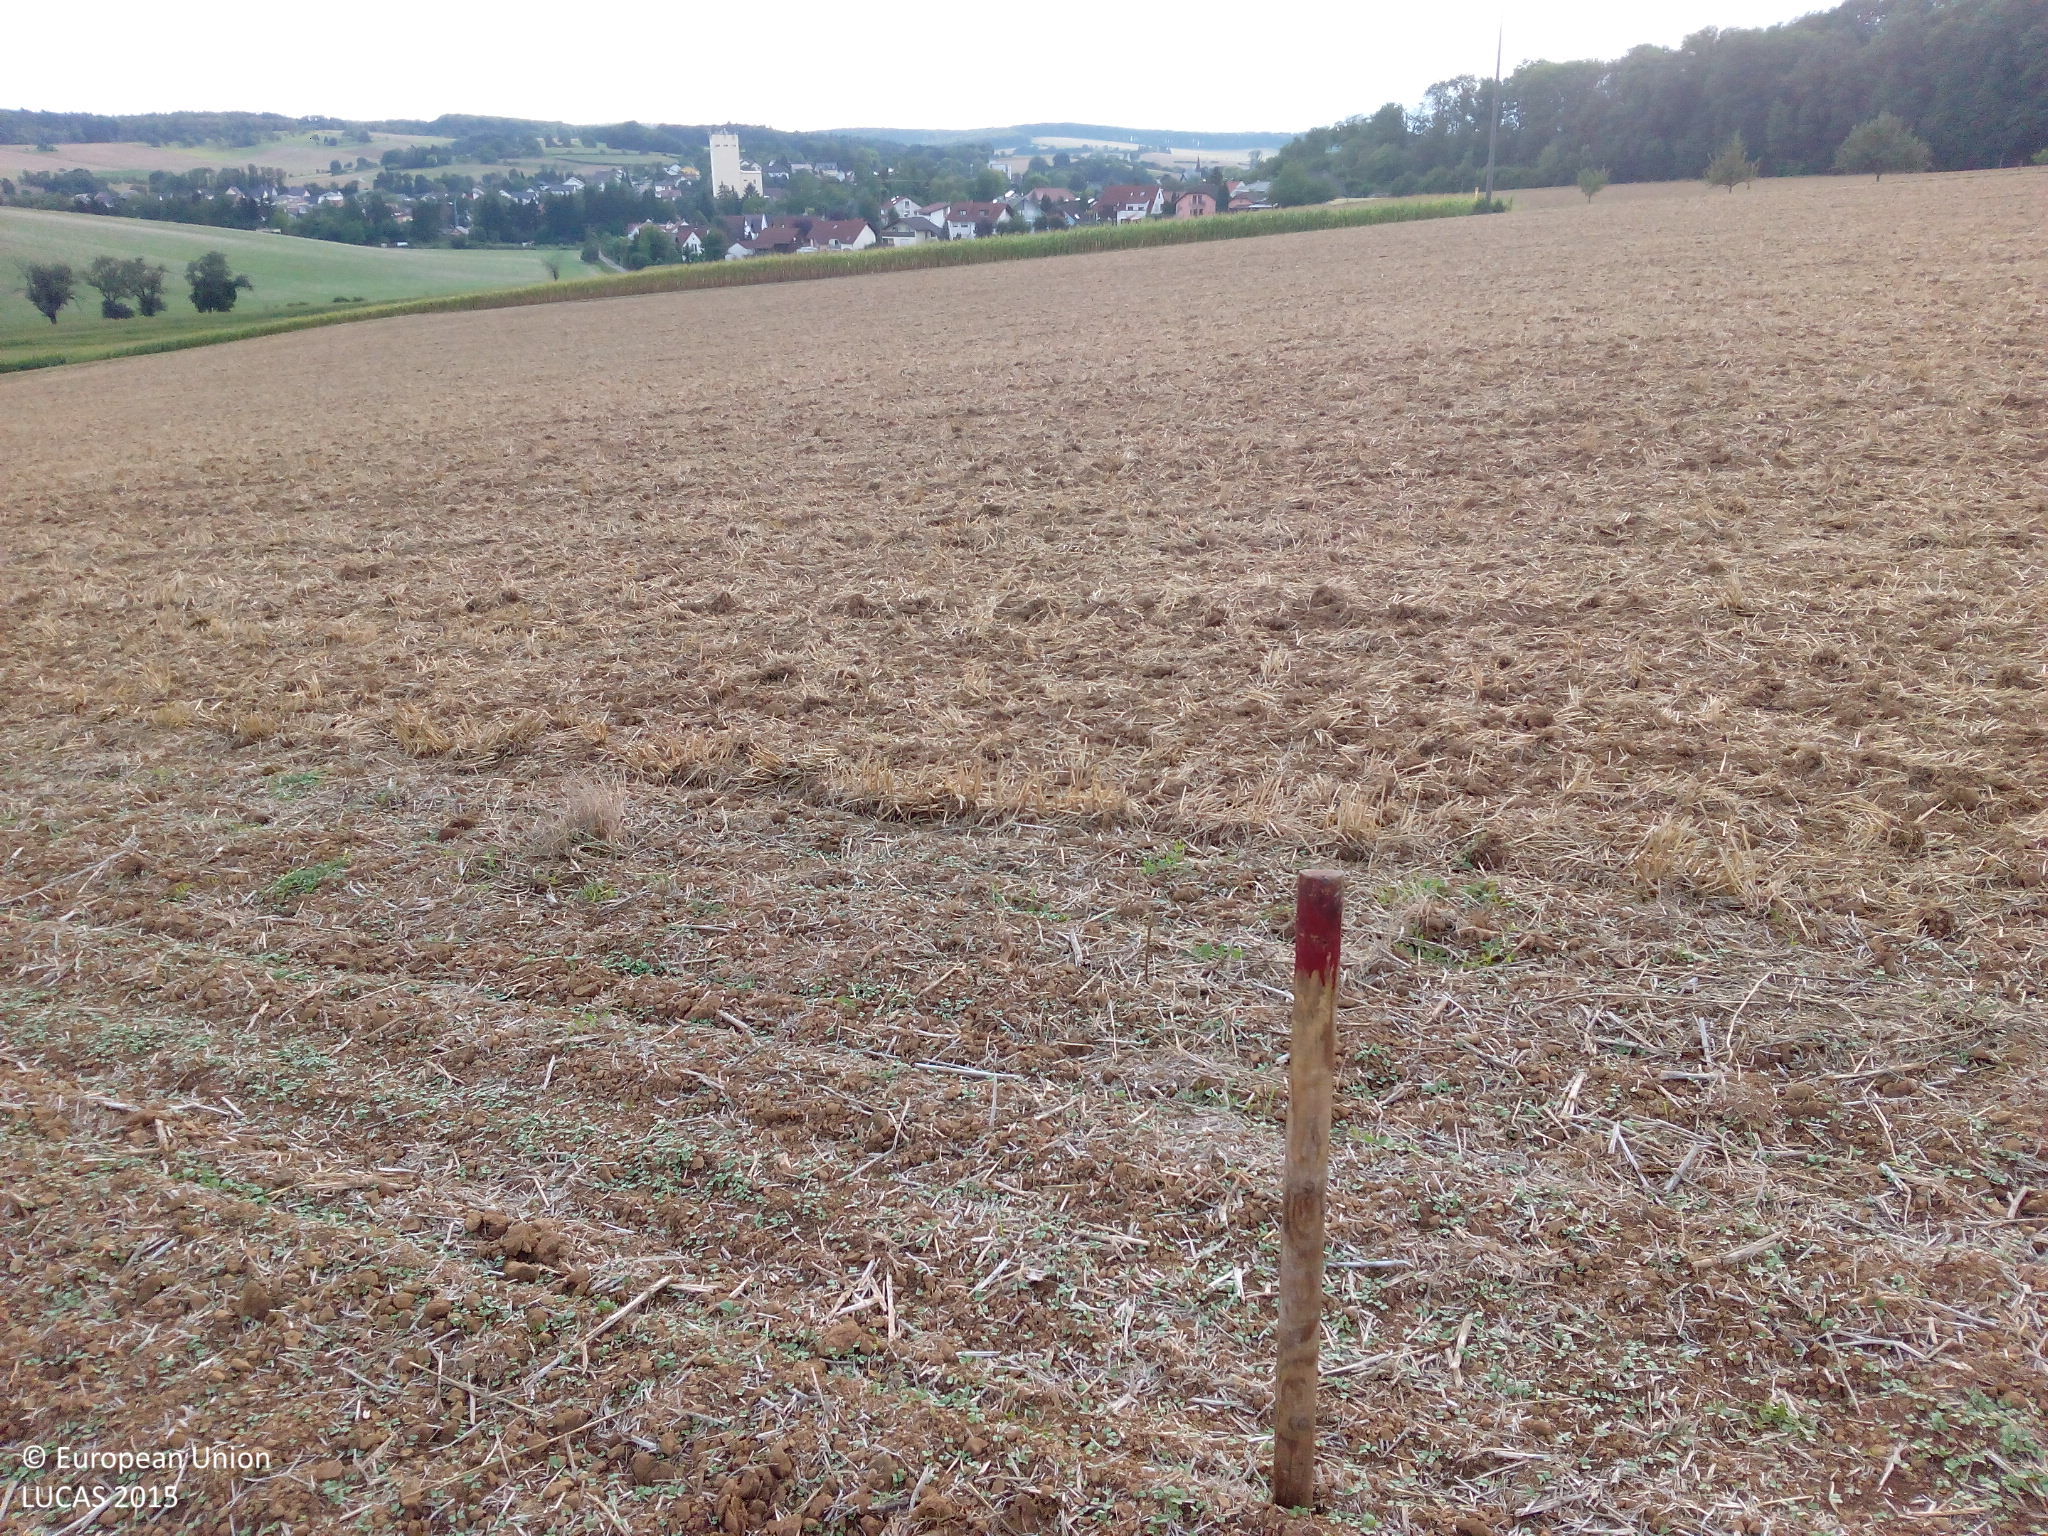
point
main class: Cropland
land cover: Rape and turnip rape
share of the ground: < 10 %
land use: Agriculture (excluding fallow land and kitchen gardens)
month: August
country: DE
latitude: 49.0613
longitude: 8.6730
